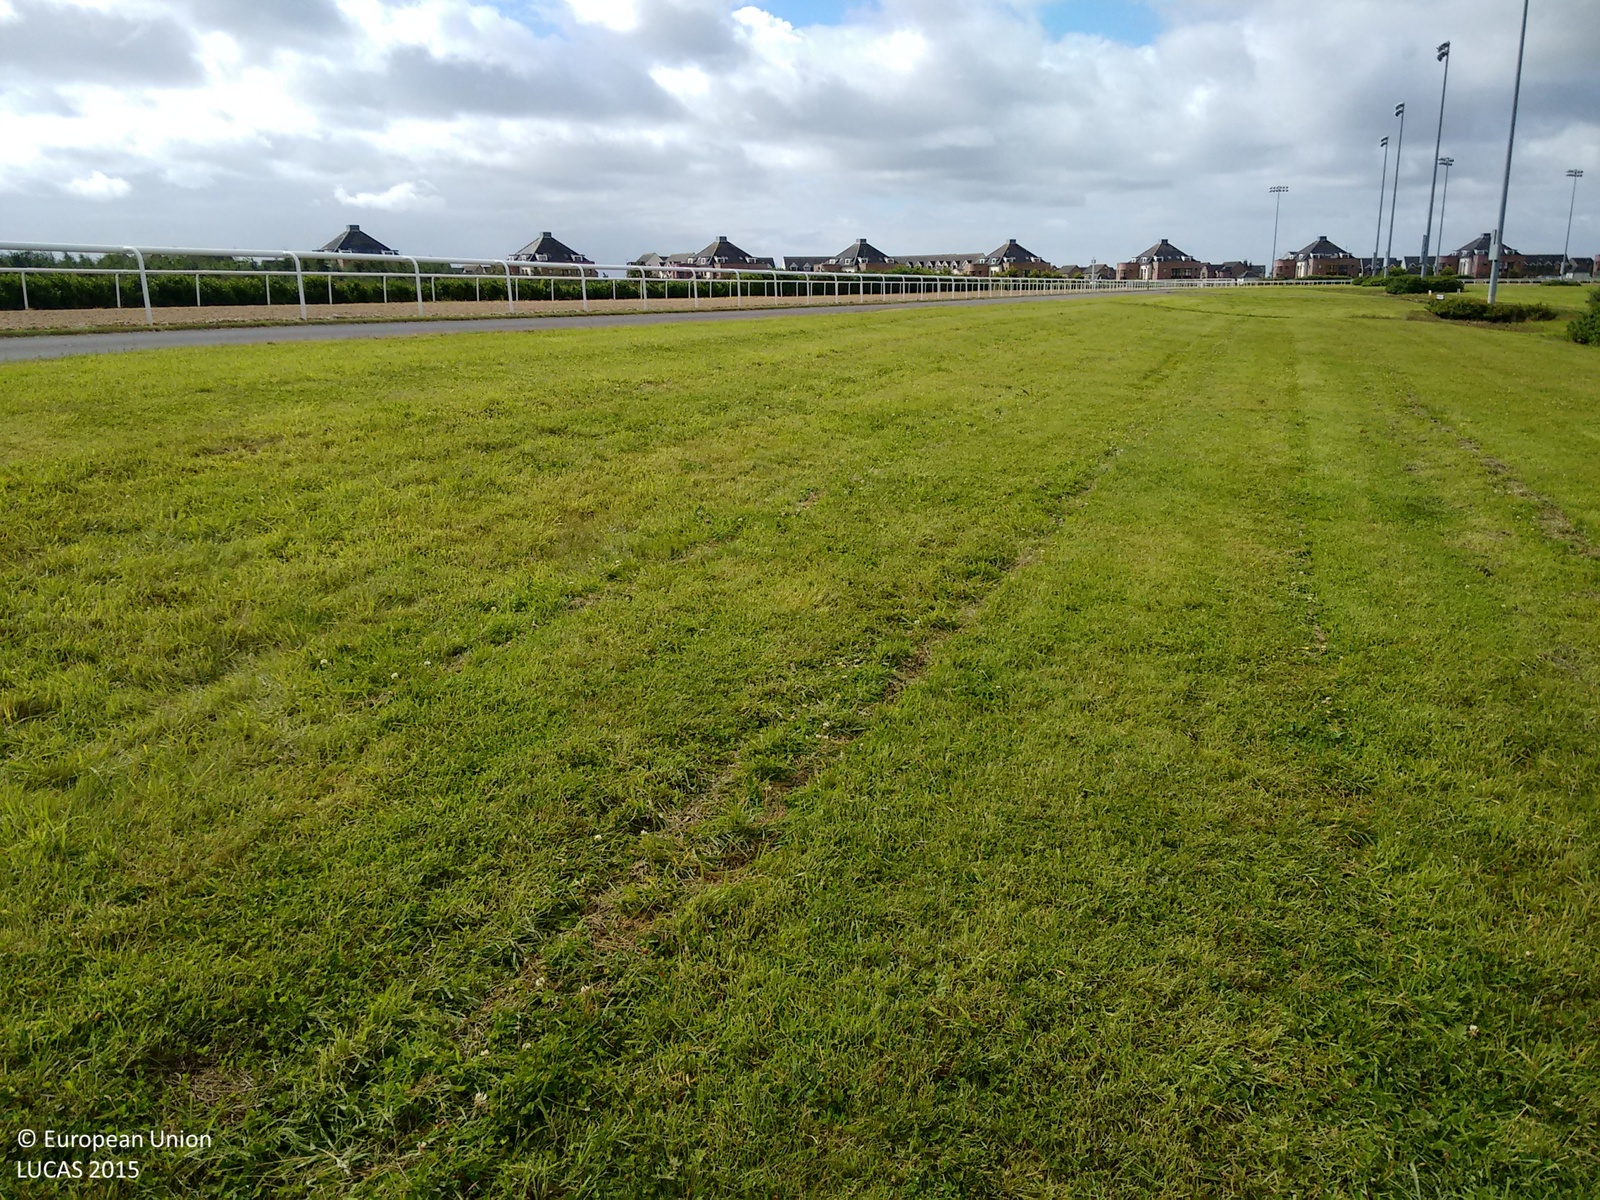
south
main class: Grassland
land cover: Grassland without tree/shrub cover
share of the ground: > 75 %
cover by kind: herbaceous plants 100 %
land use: Amenities, museums, leisure
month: August
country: IE
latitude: 54.0213
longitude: -6.3776
